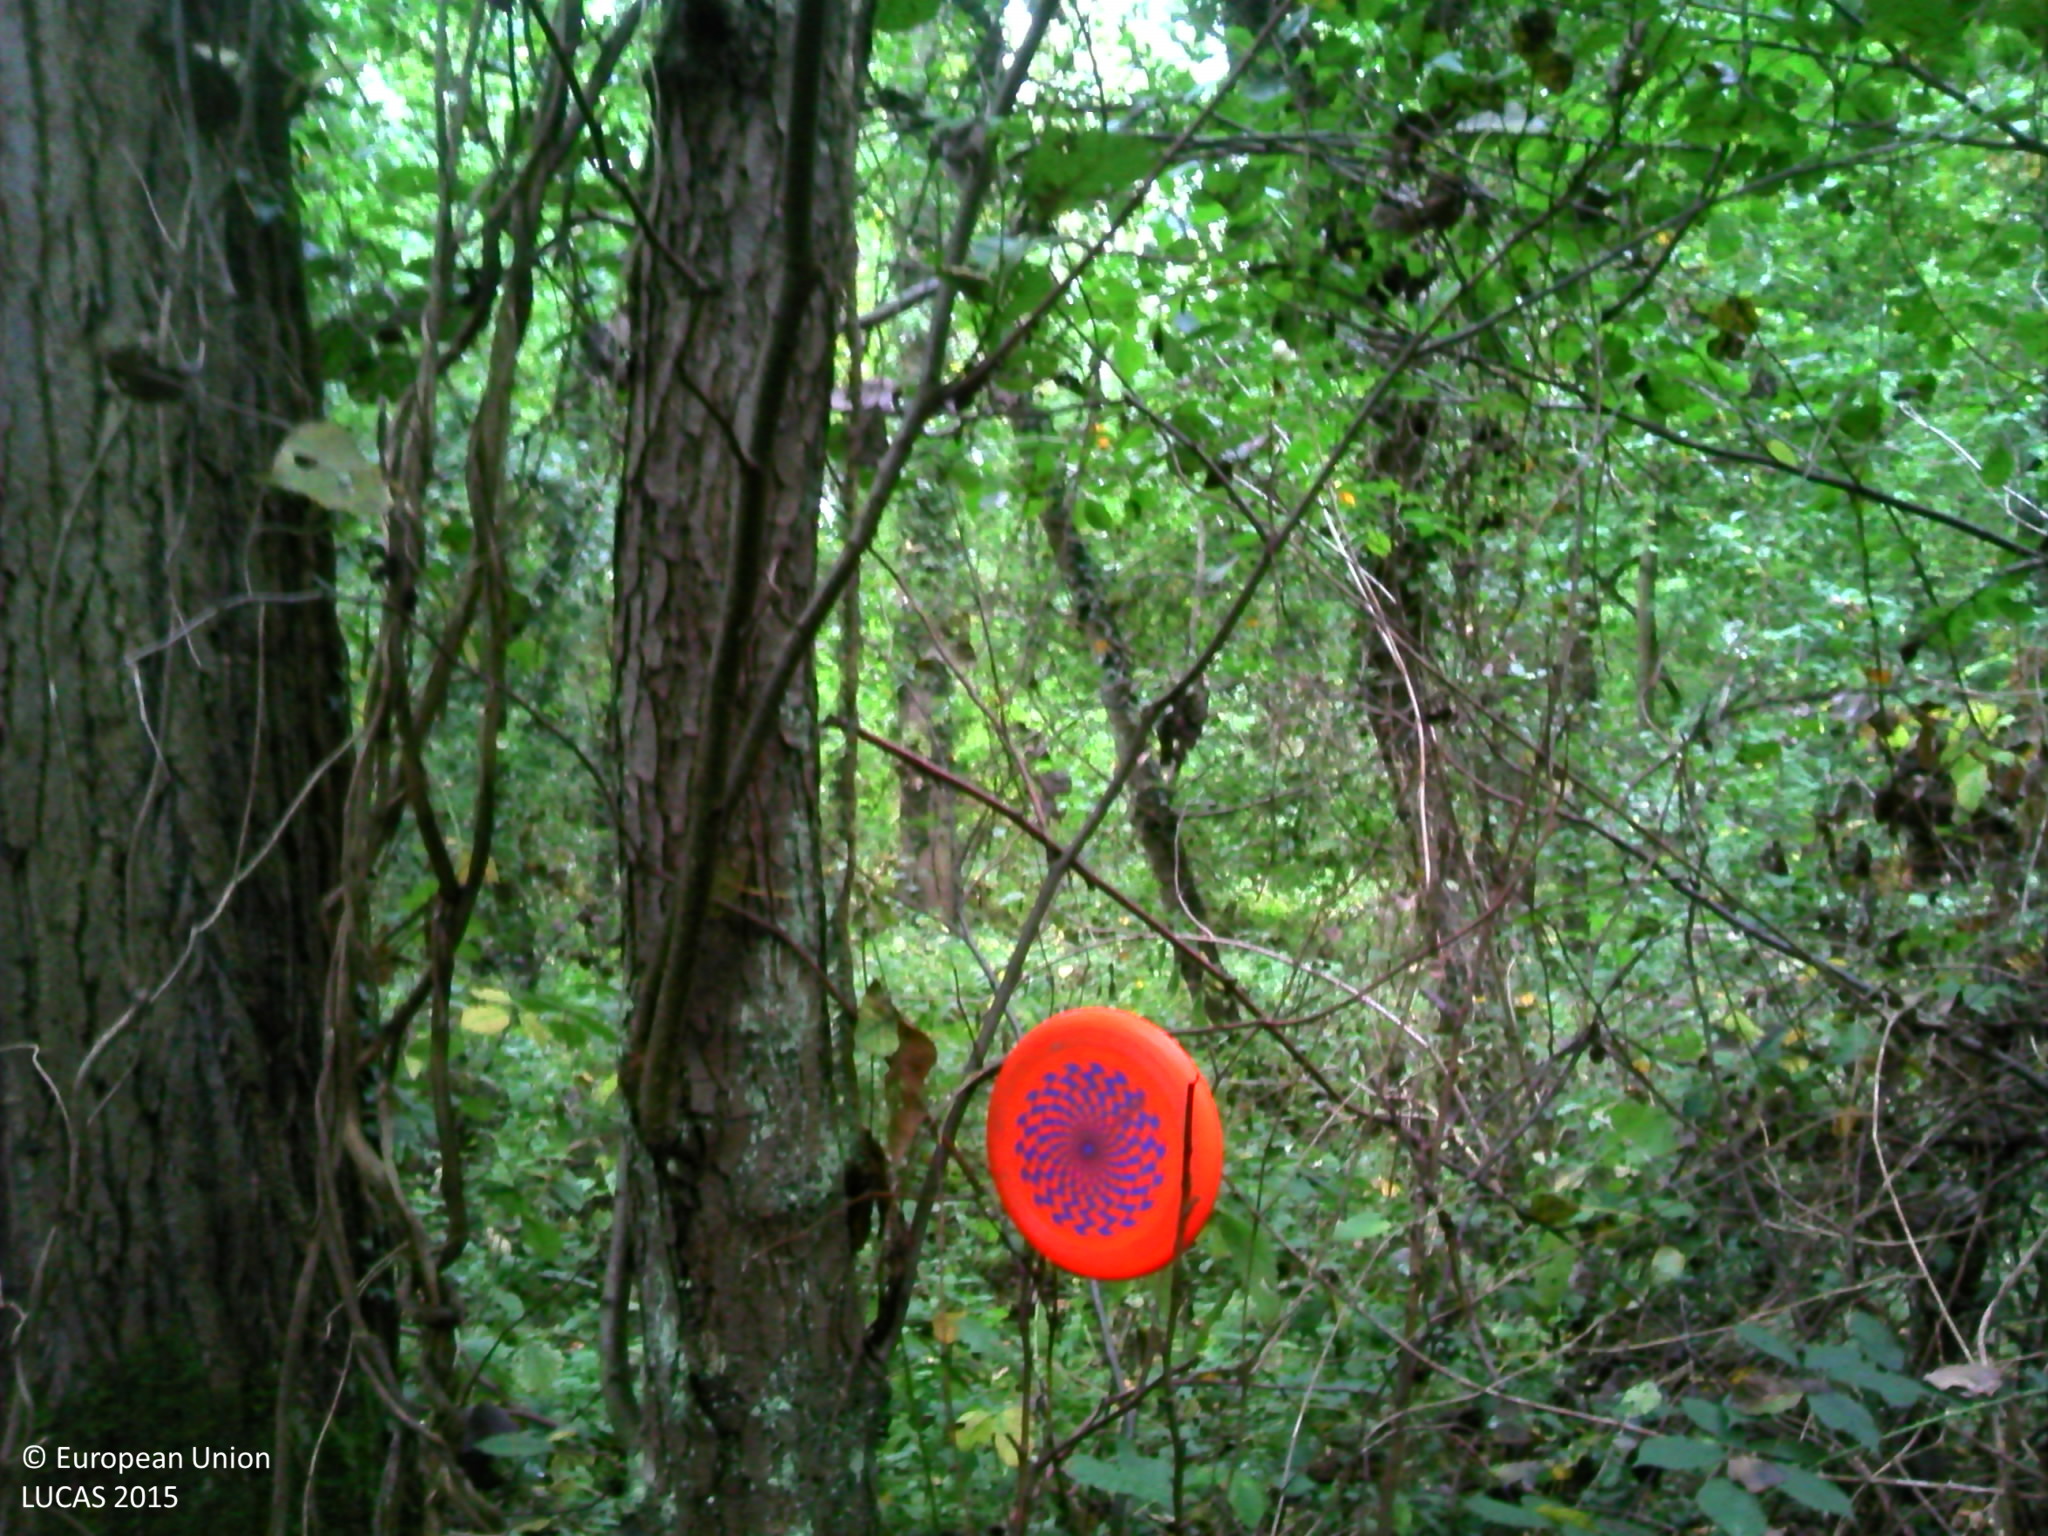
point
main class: Woodland
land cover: Broadleaved woodland
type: non-riverine alder, birch or aspen forest
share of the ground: > 75 %
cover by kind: broadleaved forest trees 80 %, herbaceous plants 20 %
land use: Forestry
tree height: > 5 m
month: October
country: BE
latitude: 51.0216
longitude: 4.8216
